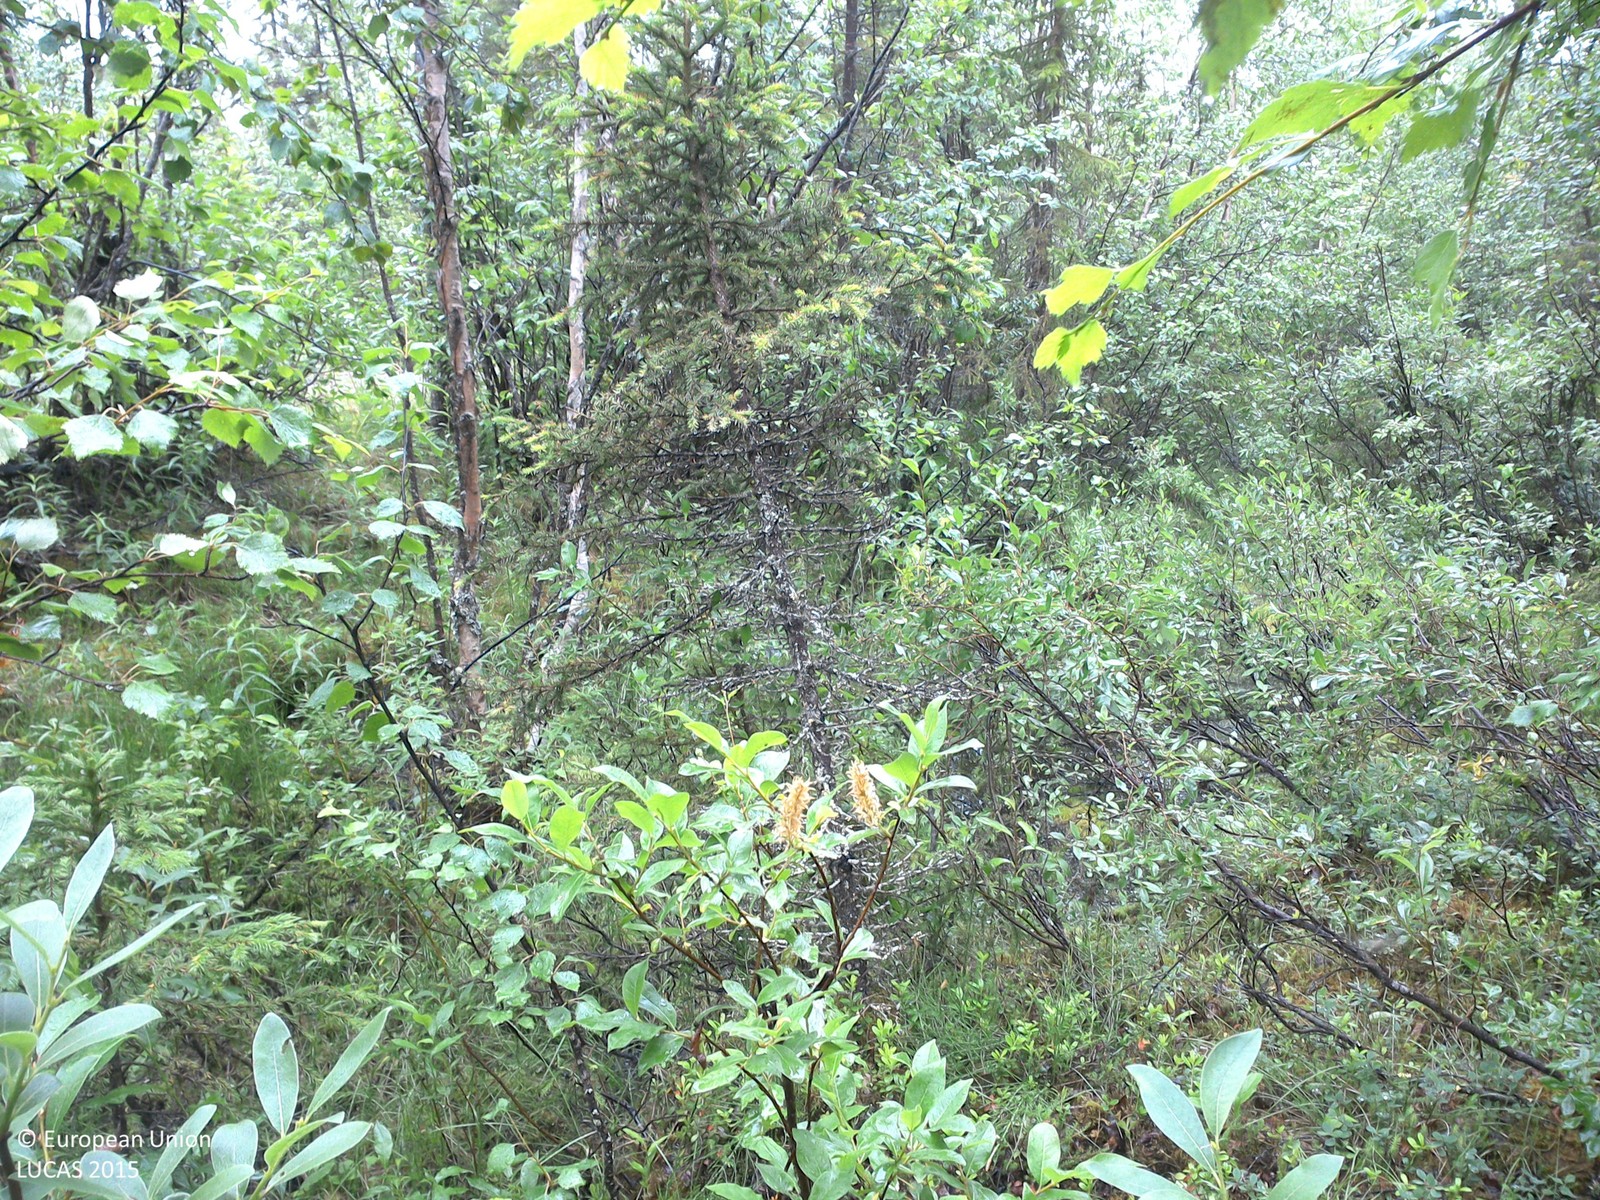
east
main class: Woodland
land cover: Spruce dominated mixed woodland
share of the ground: 25 - 50 %
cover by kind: shrubs 50 %, coniferous forest trees 25 %, broadleaved forest trees 15 %, lichens and mosses 10 %
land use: Forestry
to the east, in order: Spruce dominated mixed woodland; Ditches and canals; Groves; Paved roads, cycling and walking lanes; Spruce dominated mixed woodland; Ditches and canals; Spruce dominated mixed woodland; Spruce dominated coniferous woodland; Spruce dominated mixed woodland; Broadleaved woodland
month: July
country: SE
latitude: 67.6632
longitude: 21.4772
